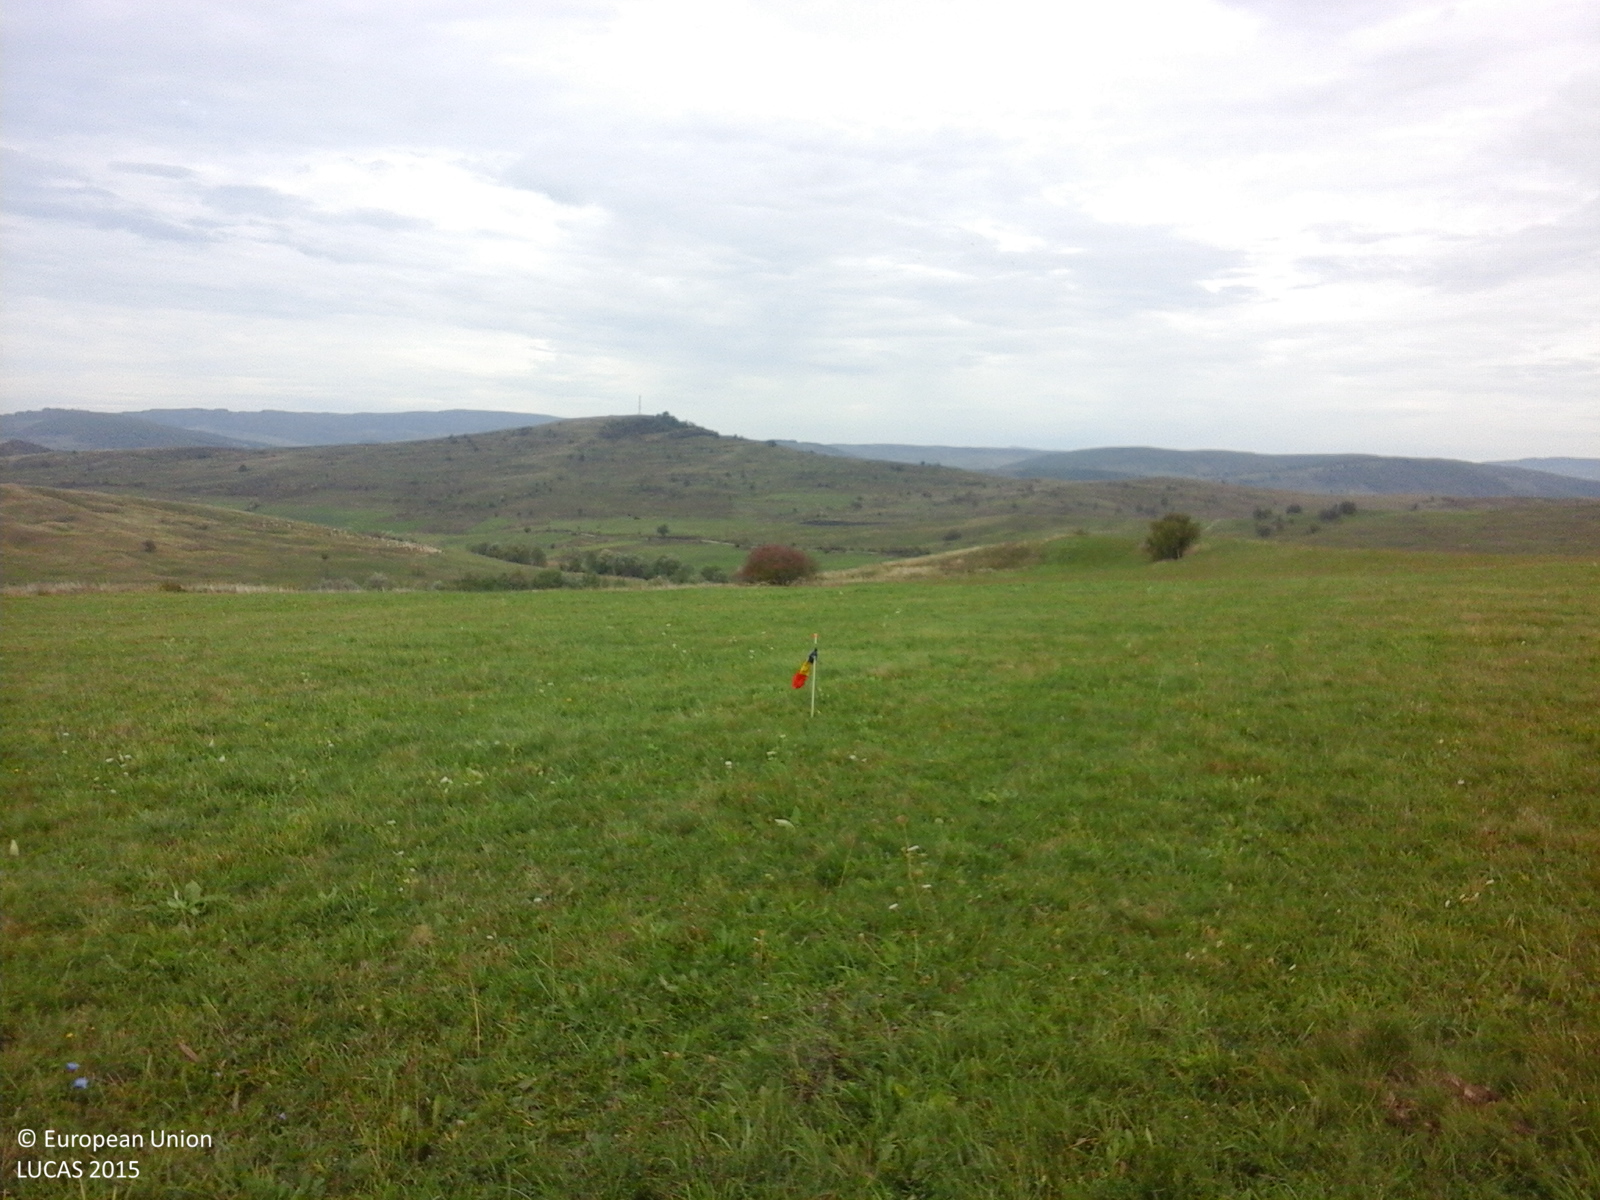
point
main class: Grassland
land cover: Grassland without tree/shrub cover
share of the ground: > 75 %
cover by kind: herbaceous plants 100 %
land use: Agriculture (excluding fallow land and kitchen gardens)
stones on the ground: < 10 %
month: October
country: RO
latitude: 46.2335
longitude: 25.2863
